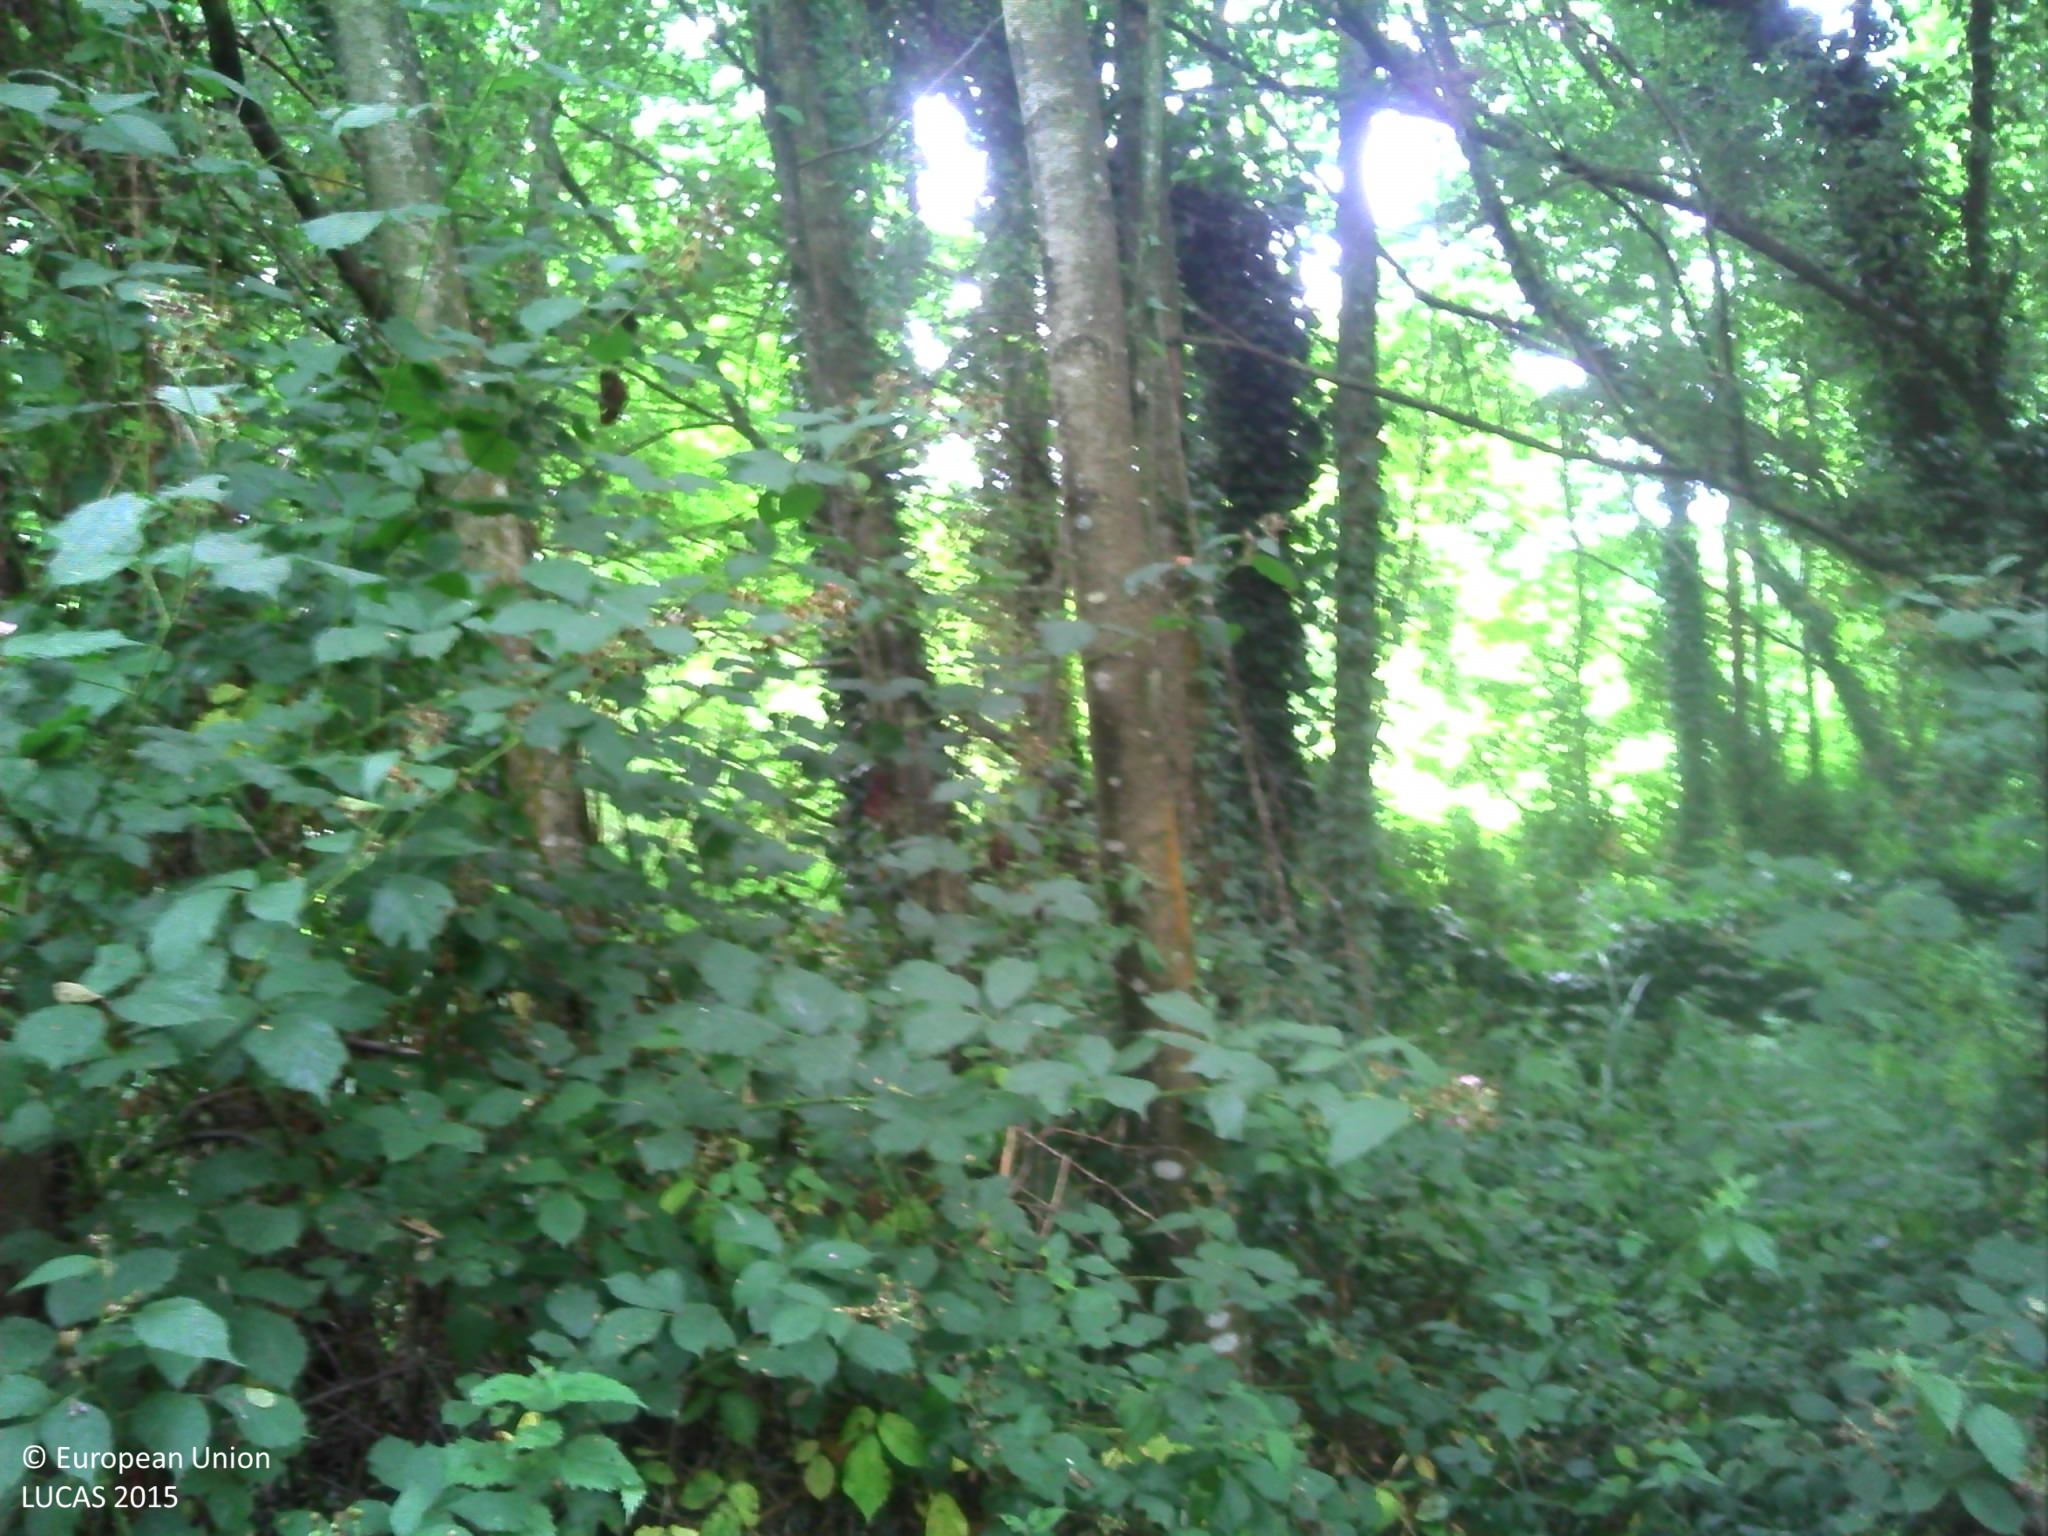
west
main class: Woodland
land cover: Broadleaved woodland
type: floodplain forest
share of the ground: > 75 %
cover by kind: broadleaved forest trees 90 %, shrubs 10 %
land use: Semi-natural and natural areas not in use
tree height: > 5 m
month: July
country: FR
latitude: 48.7272
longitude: -1.5081
